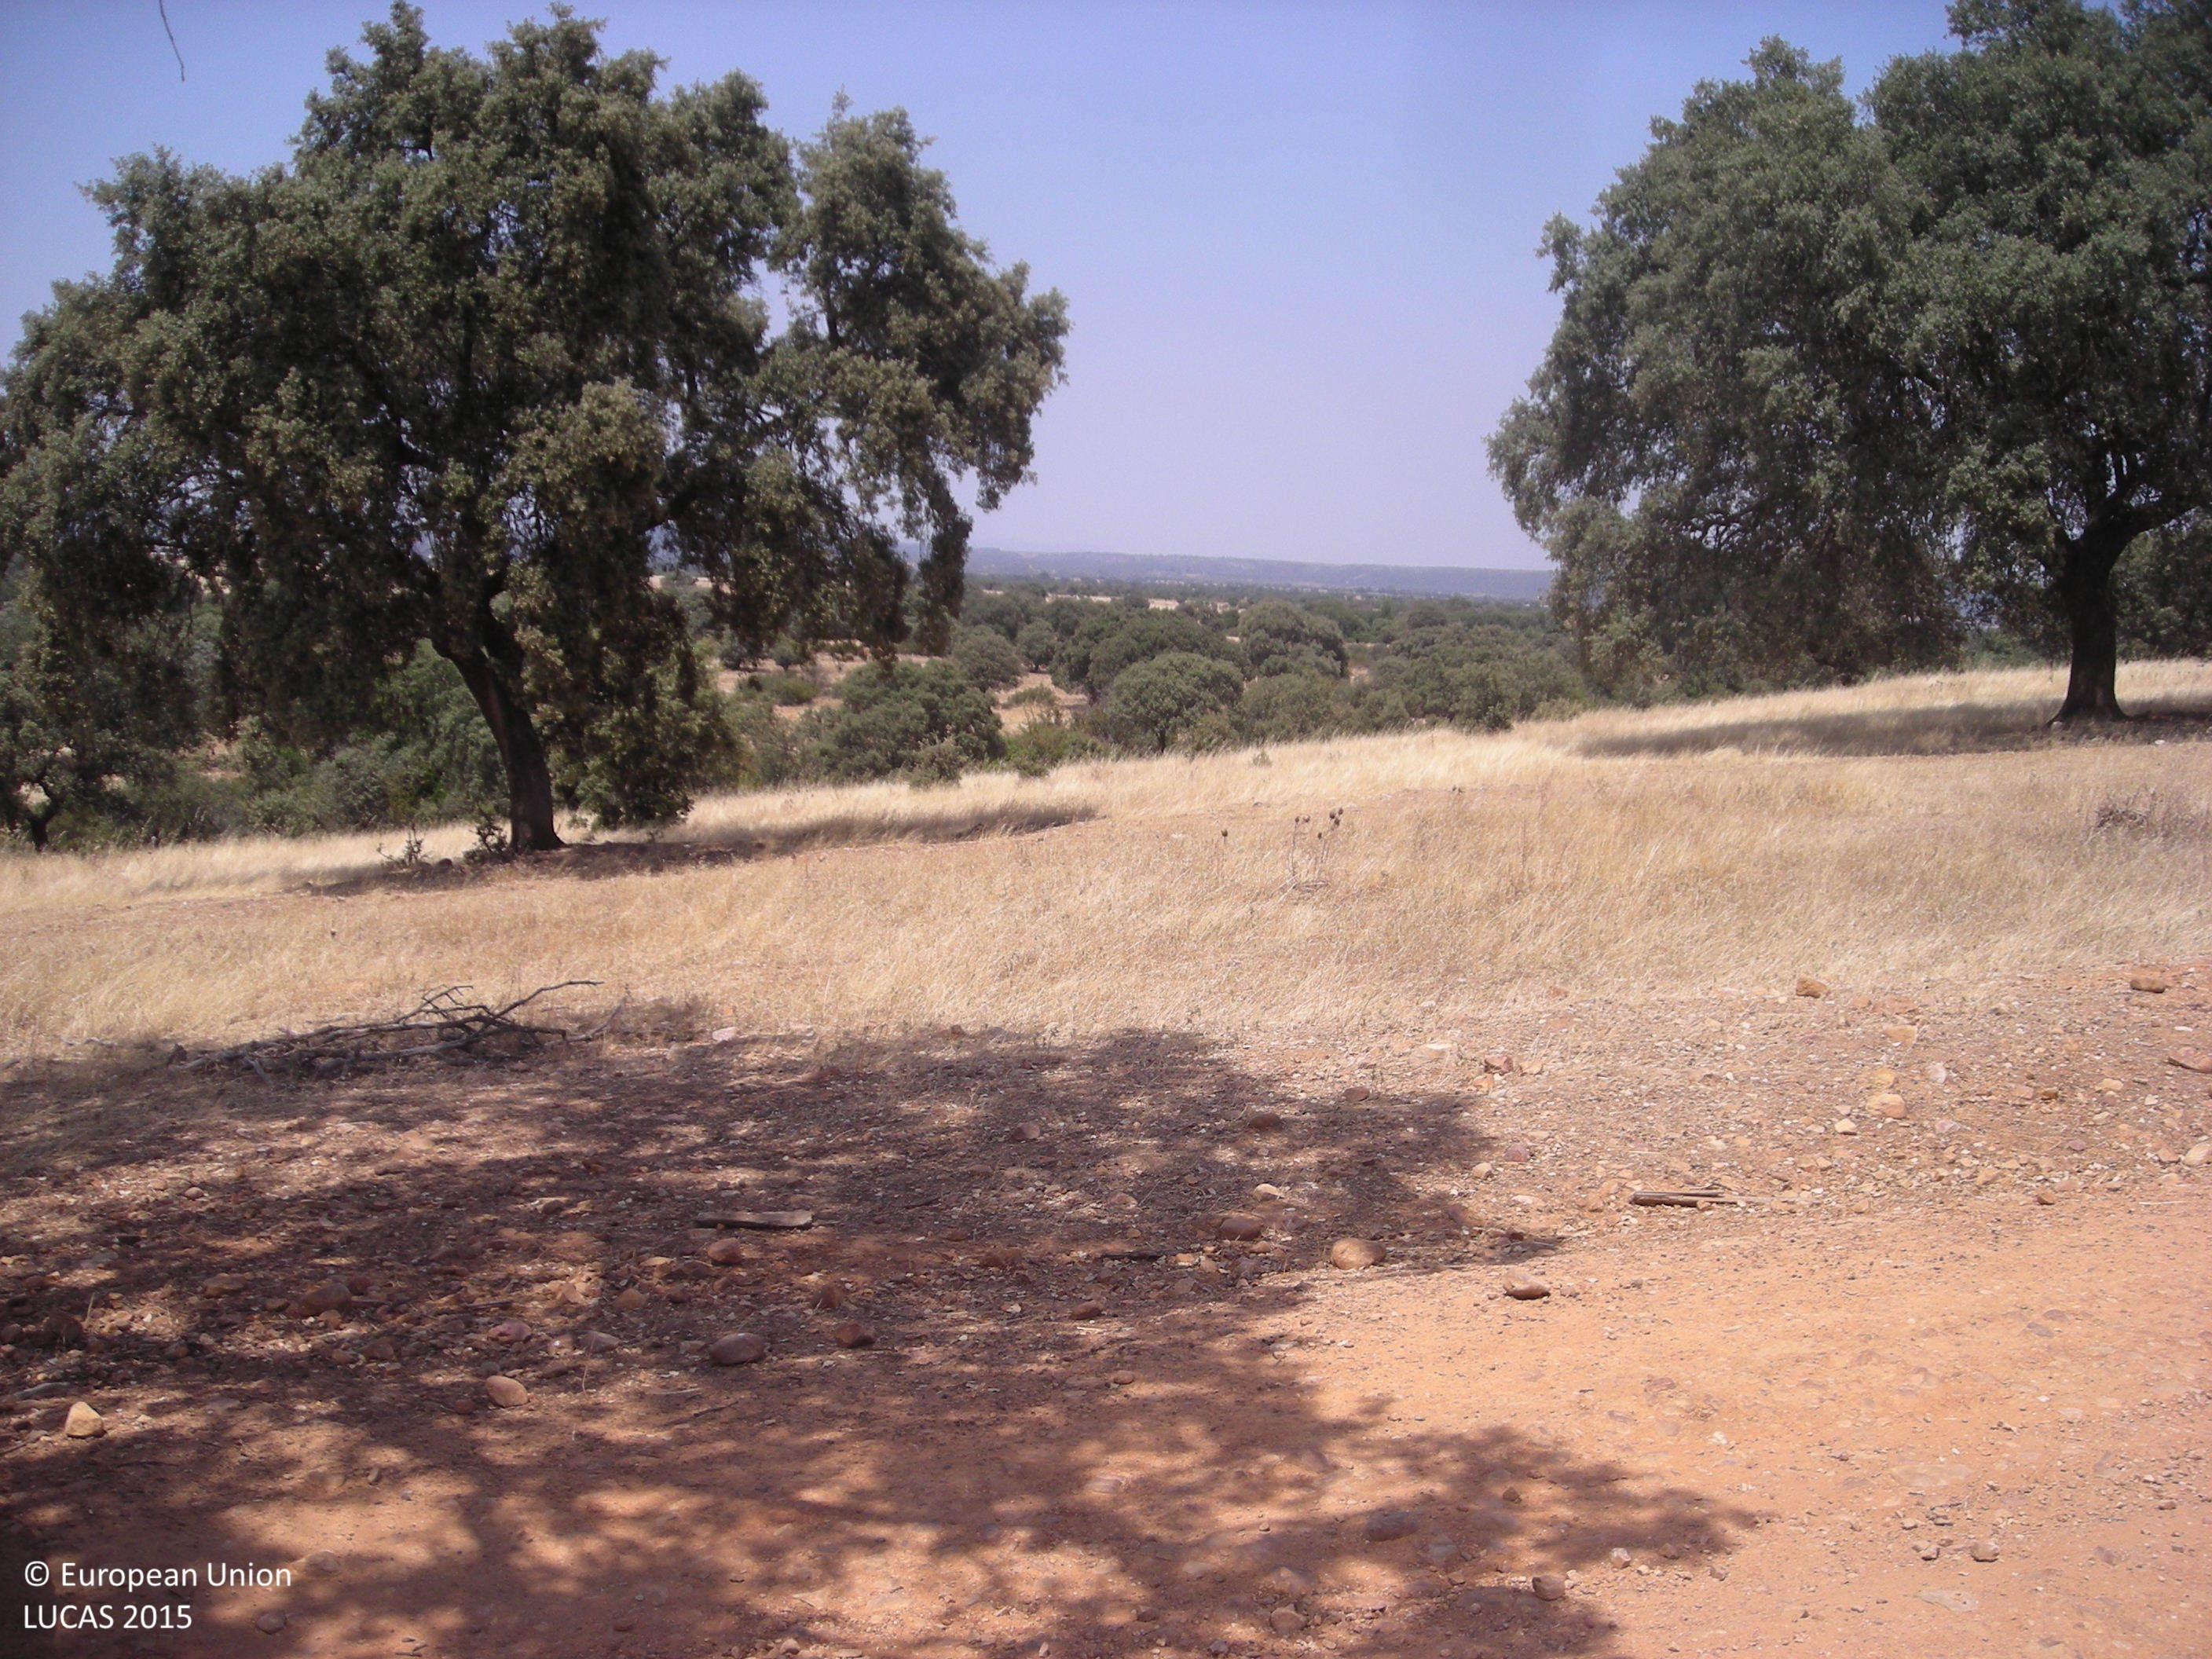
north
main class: Grassland
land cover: Grassland without tree/shrub cover
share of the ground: > 75 %
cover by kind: herbaceous plants 100 %
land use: Agriculture (excluding fallow land and kitchen gardens)
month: July
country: ES
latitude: 39.2071
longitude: -5.2953
